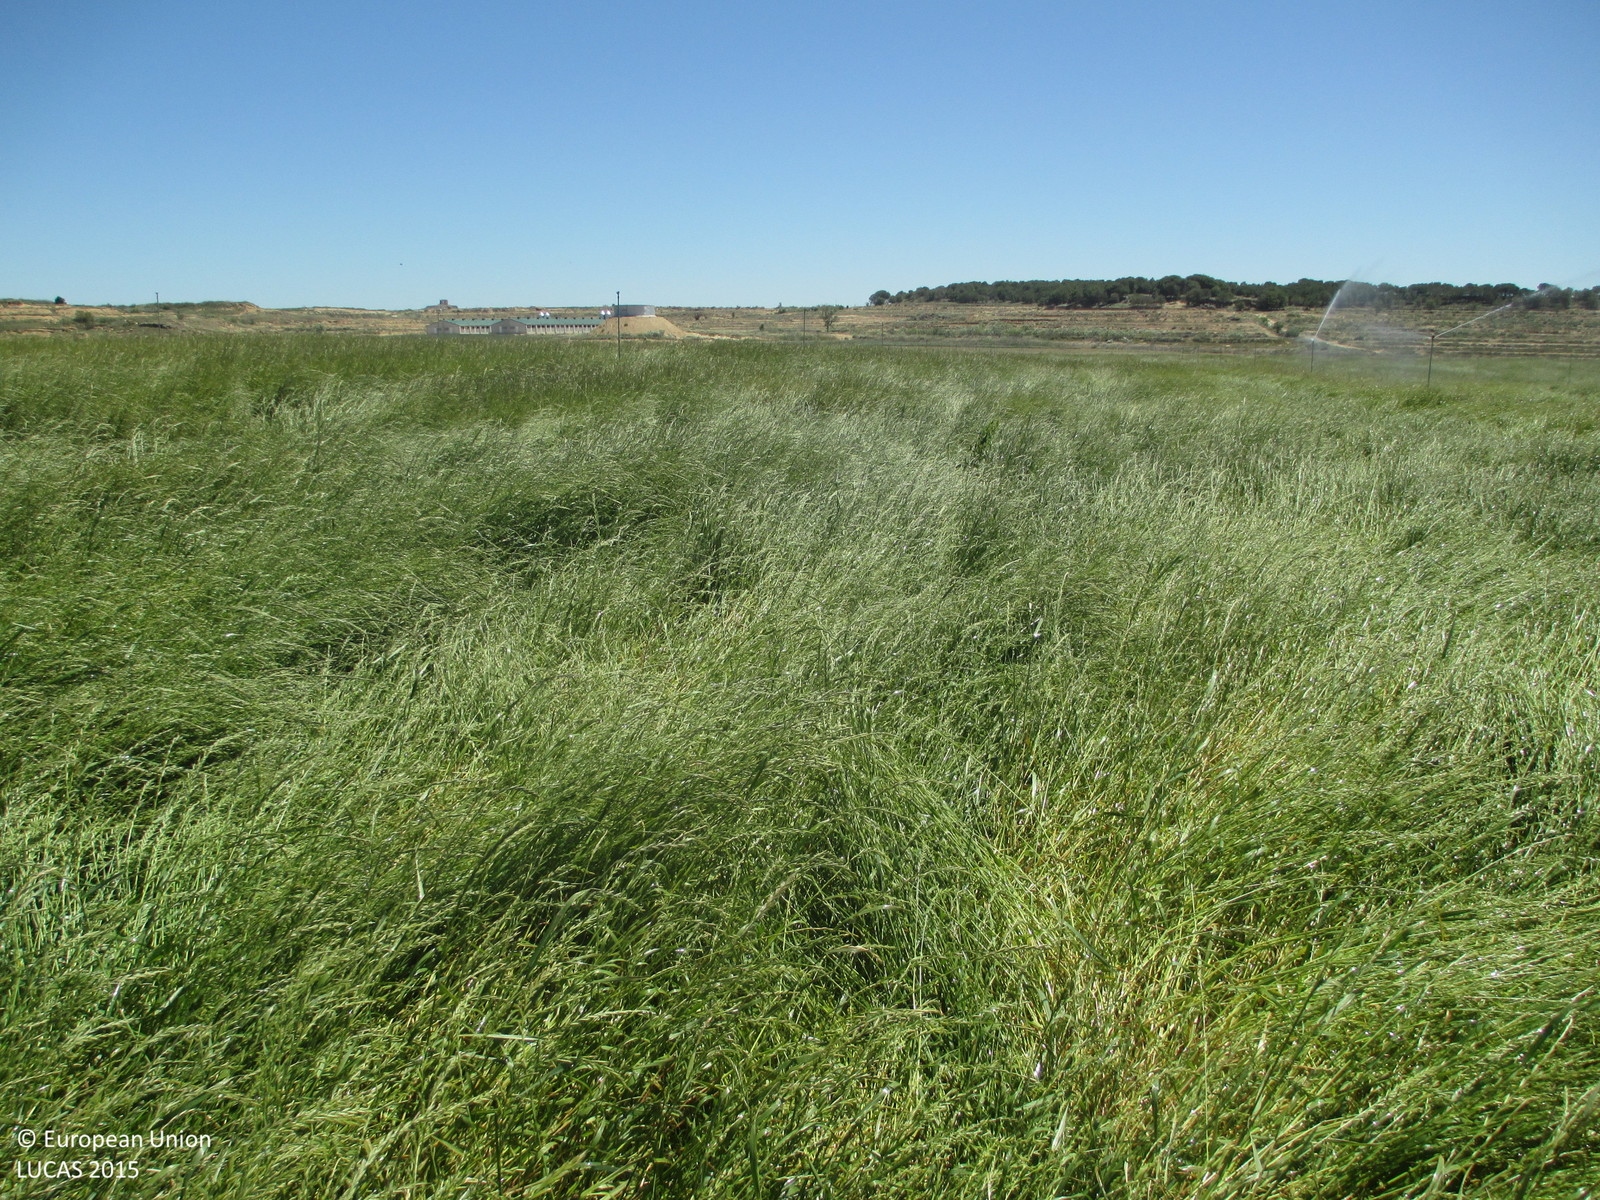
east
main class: Cropland
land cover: Temporary grasslands
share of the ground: > 75 %
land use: Agriculture (excluding fallow land and kitchen gardens)
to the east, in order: Temporary grasslands; Spontaneously vegetated surfaces; Shruby margins; Ditches and canals; Shruby margins; Tracks; Shruby margins; Ditches and canals; Shruby margins; Other bare soil
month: May
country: ES
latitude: 41.8780
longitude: -0.2496
